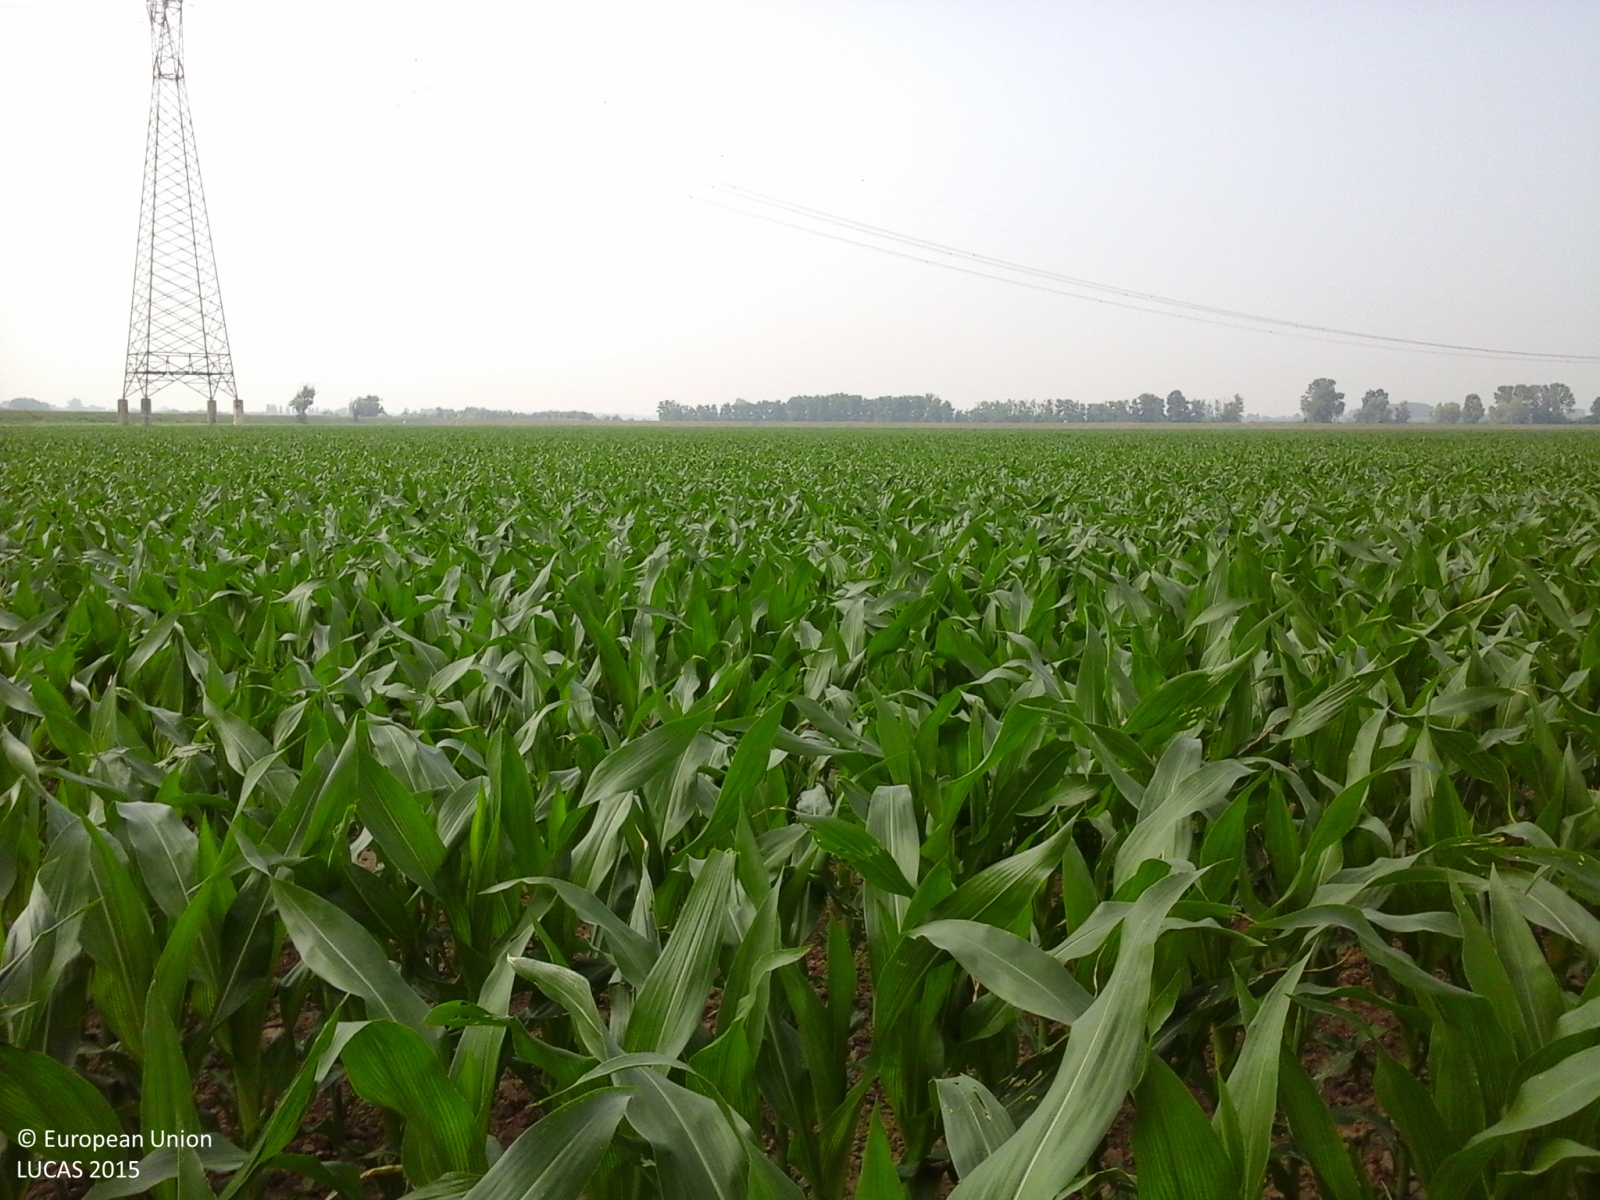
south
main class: Cropland
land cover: Maize
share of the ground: 50 - 75 %
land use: Agriculture (excluding fallow land and kitchen gardens)
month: June
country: IT
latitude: 45.0718
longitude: 10.0380
